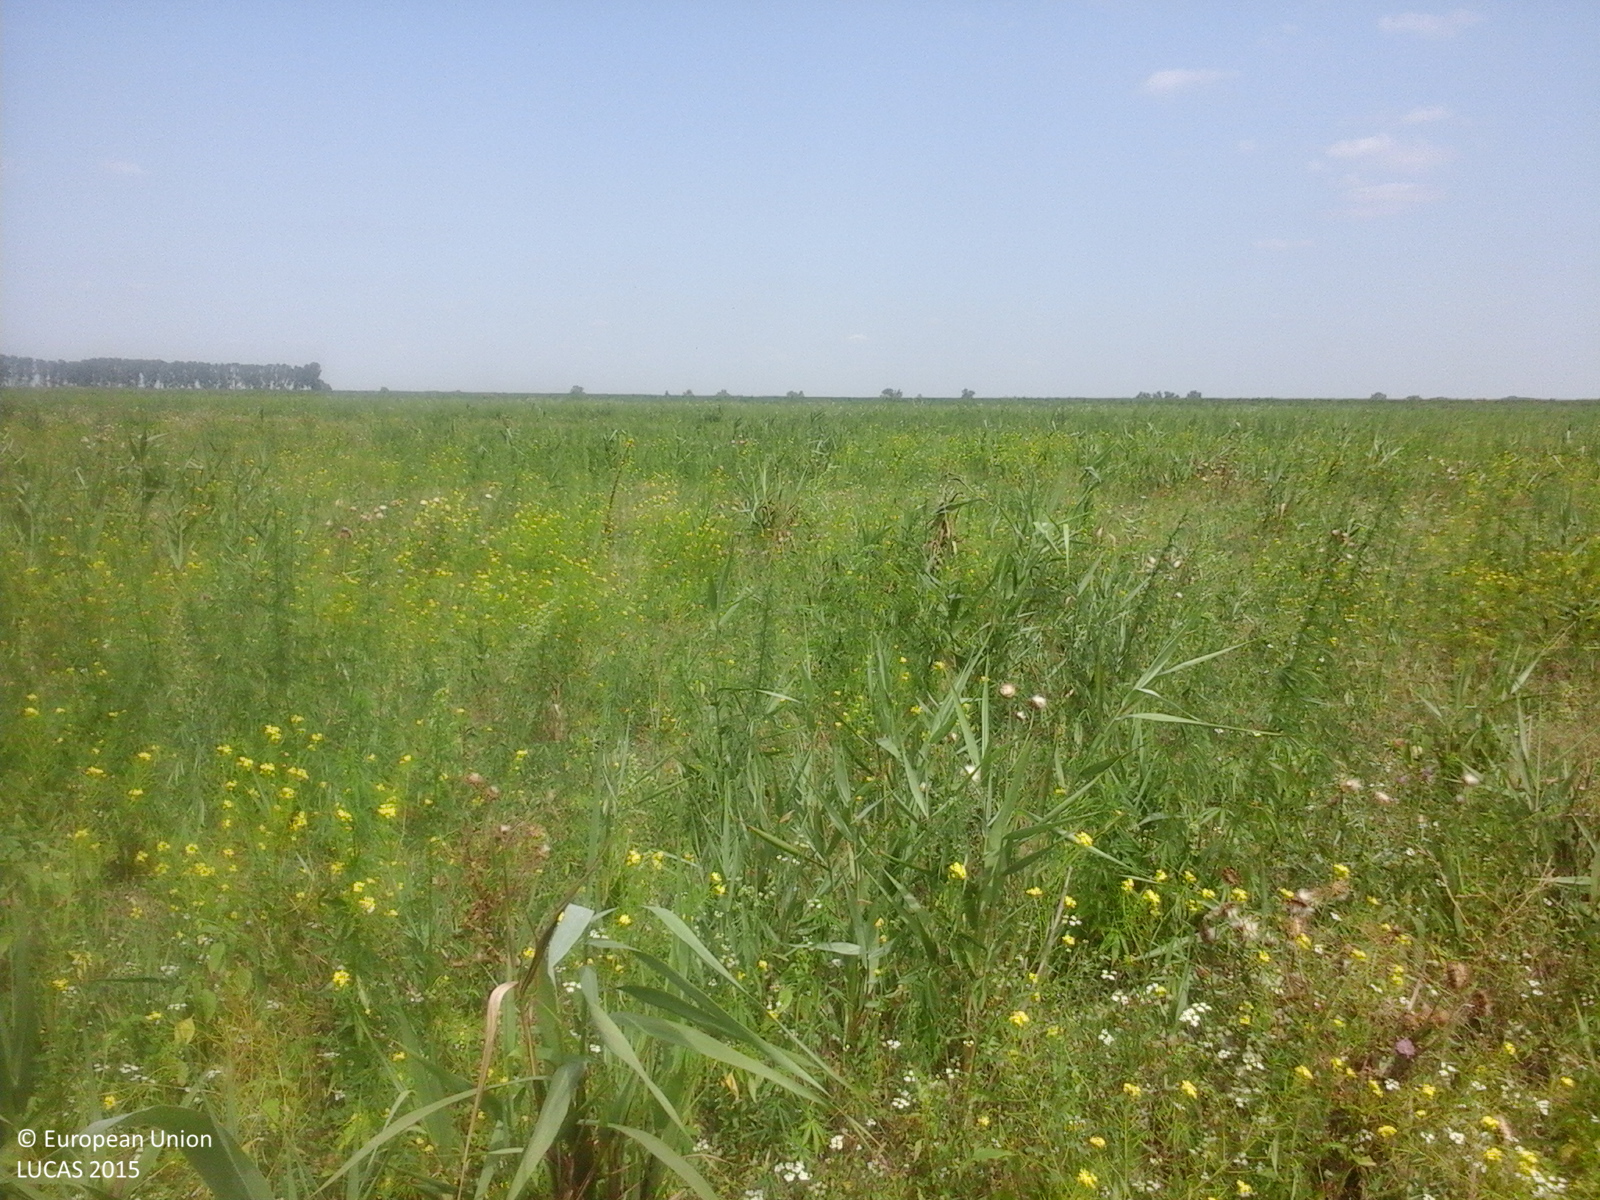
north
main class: Grassland
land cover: Spontaneously vegetated surfaces
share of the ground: > 75 %
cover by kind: herbaceous plants 100 %
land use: Semi-natural and natural areas not in use
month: August
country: RO
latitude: 45.2999
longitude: 29.0634
